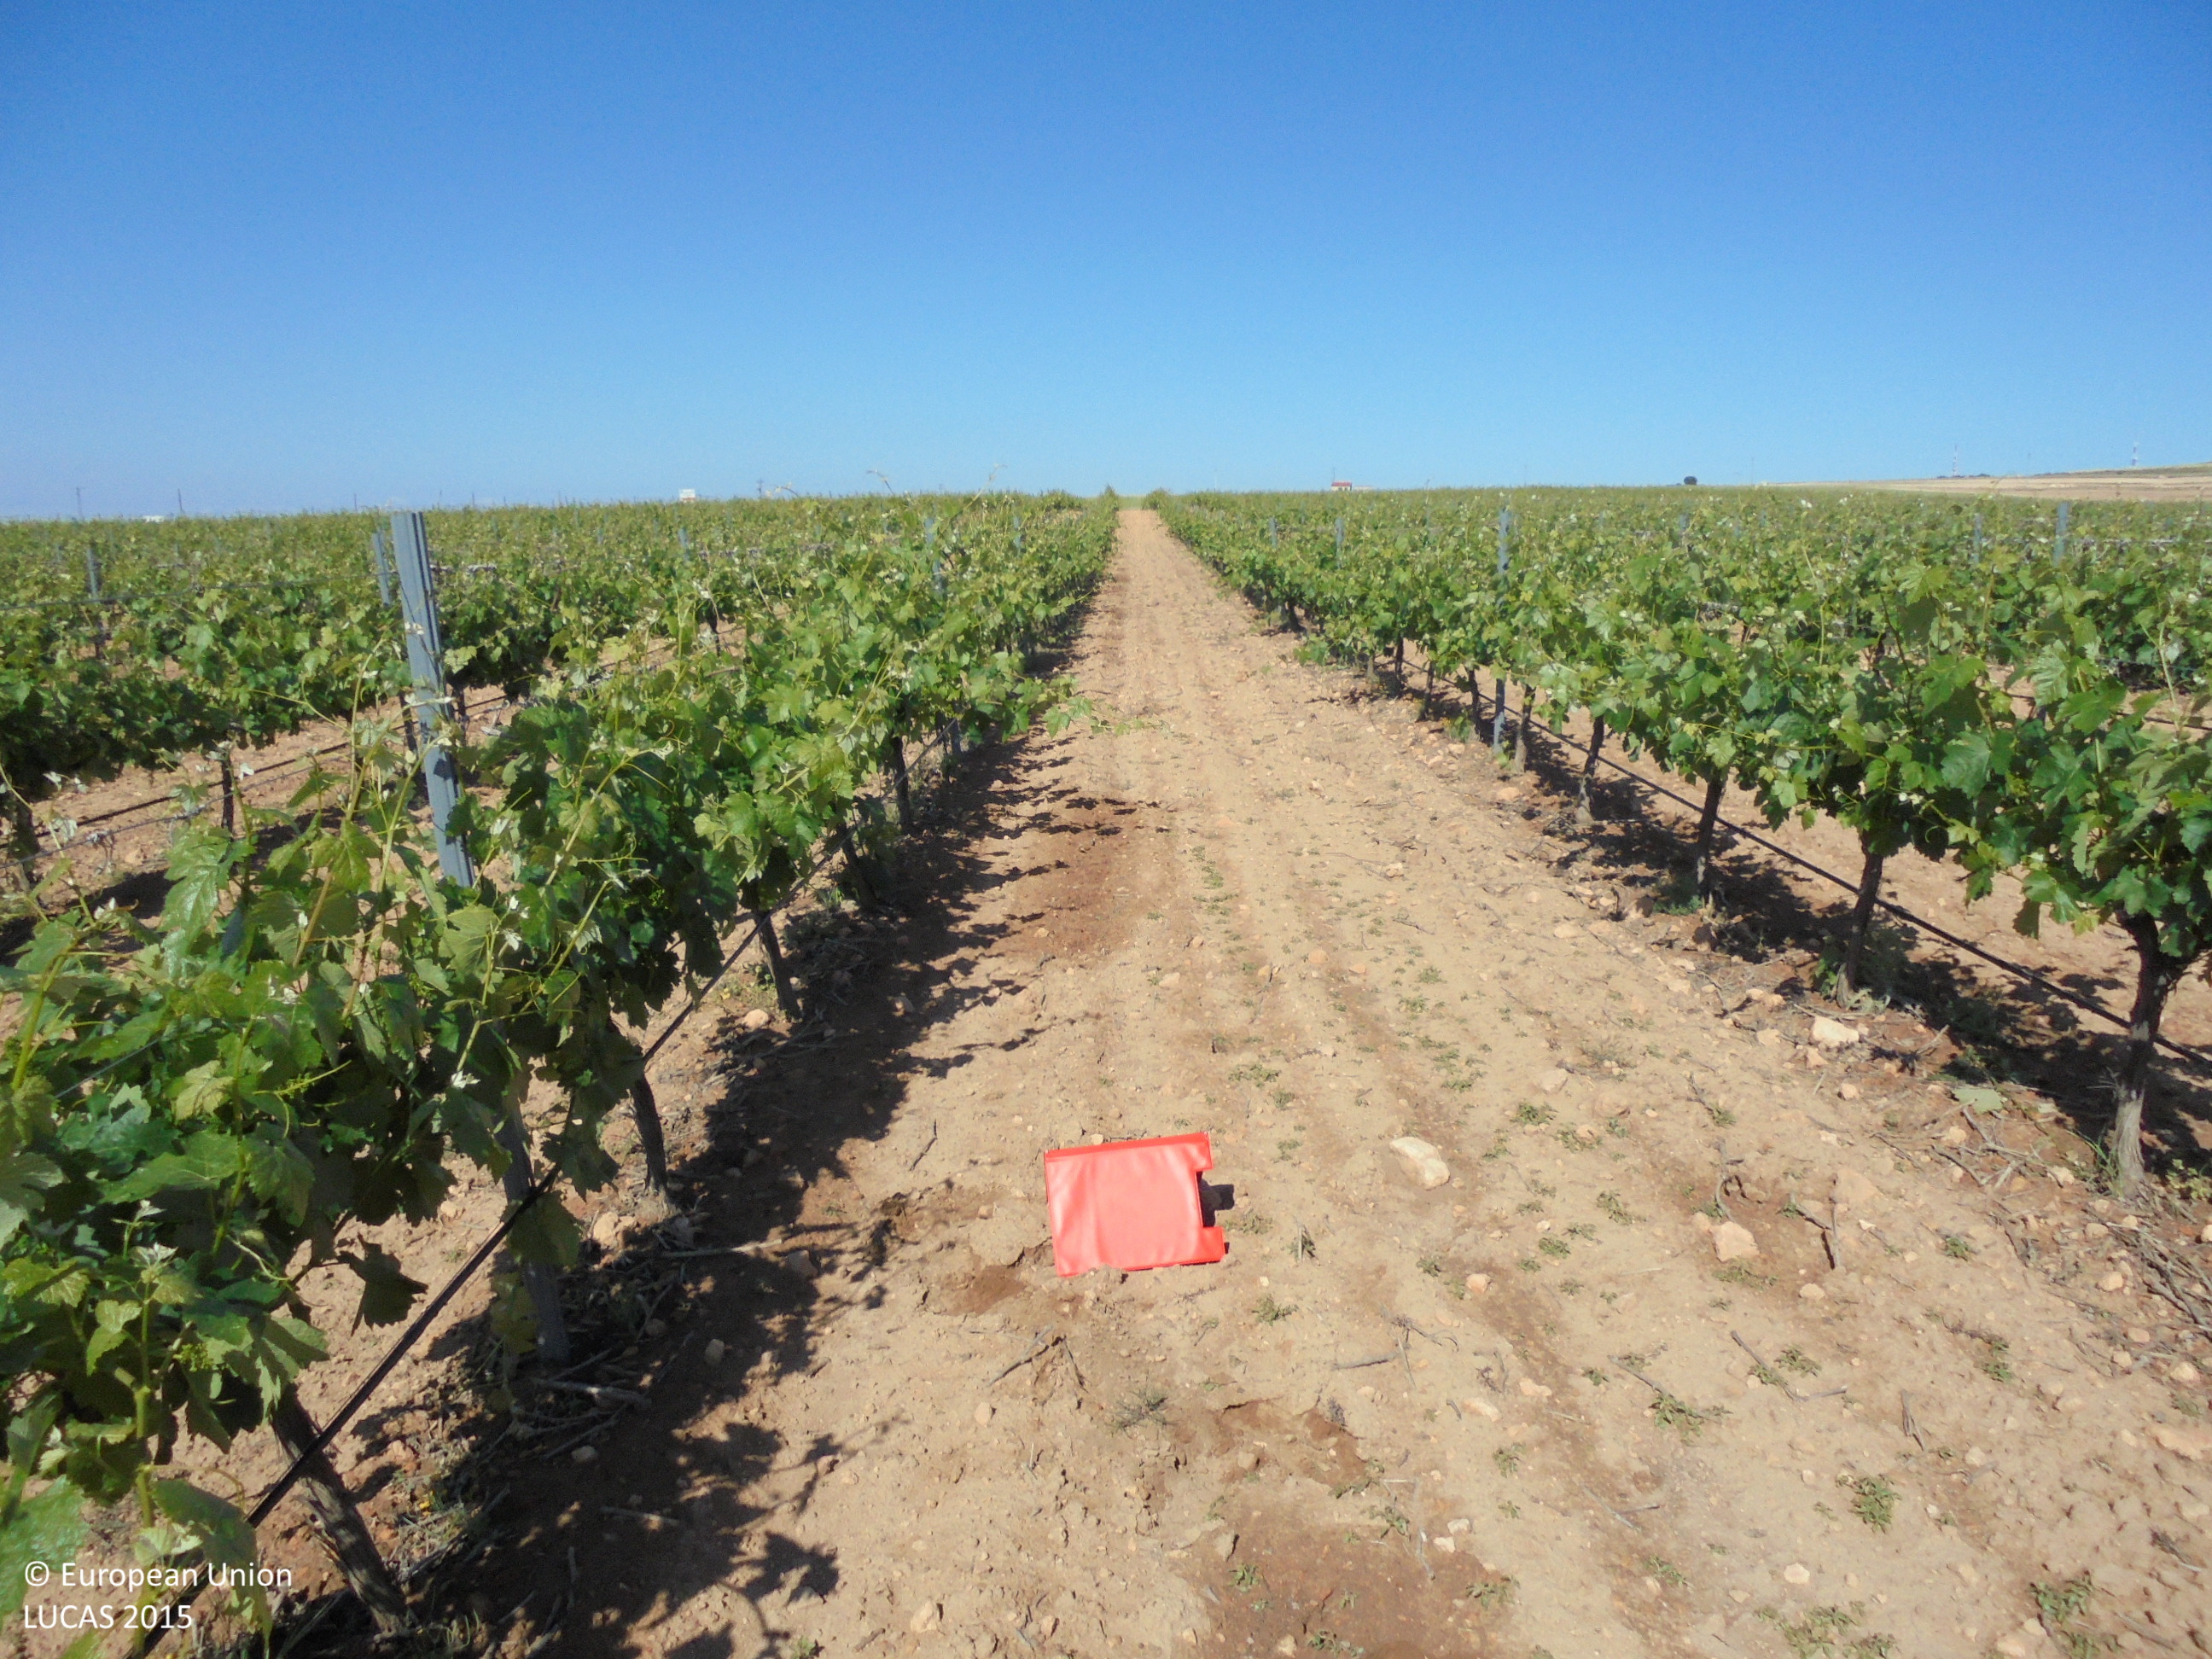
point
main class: Cropland
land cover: Vineyards
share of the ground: 25 - 50 %
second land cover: Other bare soil
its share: > 75 %
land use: Agriculture (excluding fallow land and kitchen gardens)
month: May
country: ES
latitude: 38.9094
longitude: -1.6801
